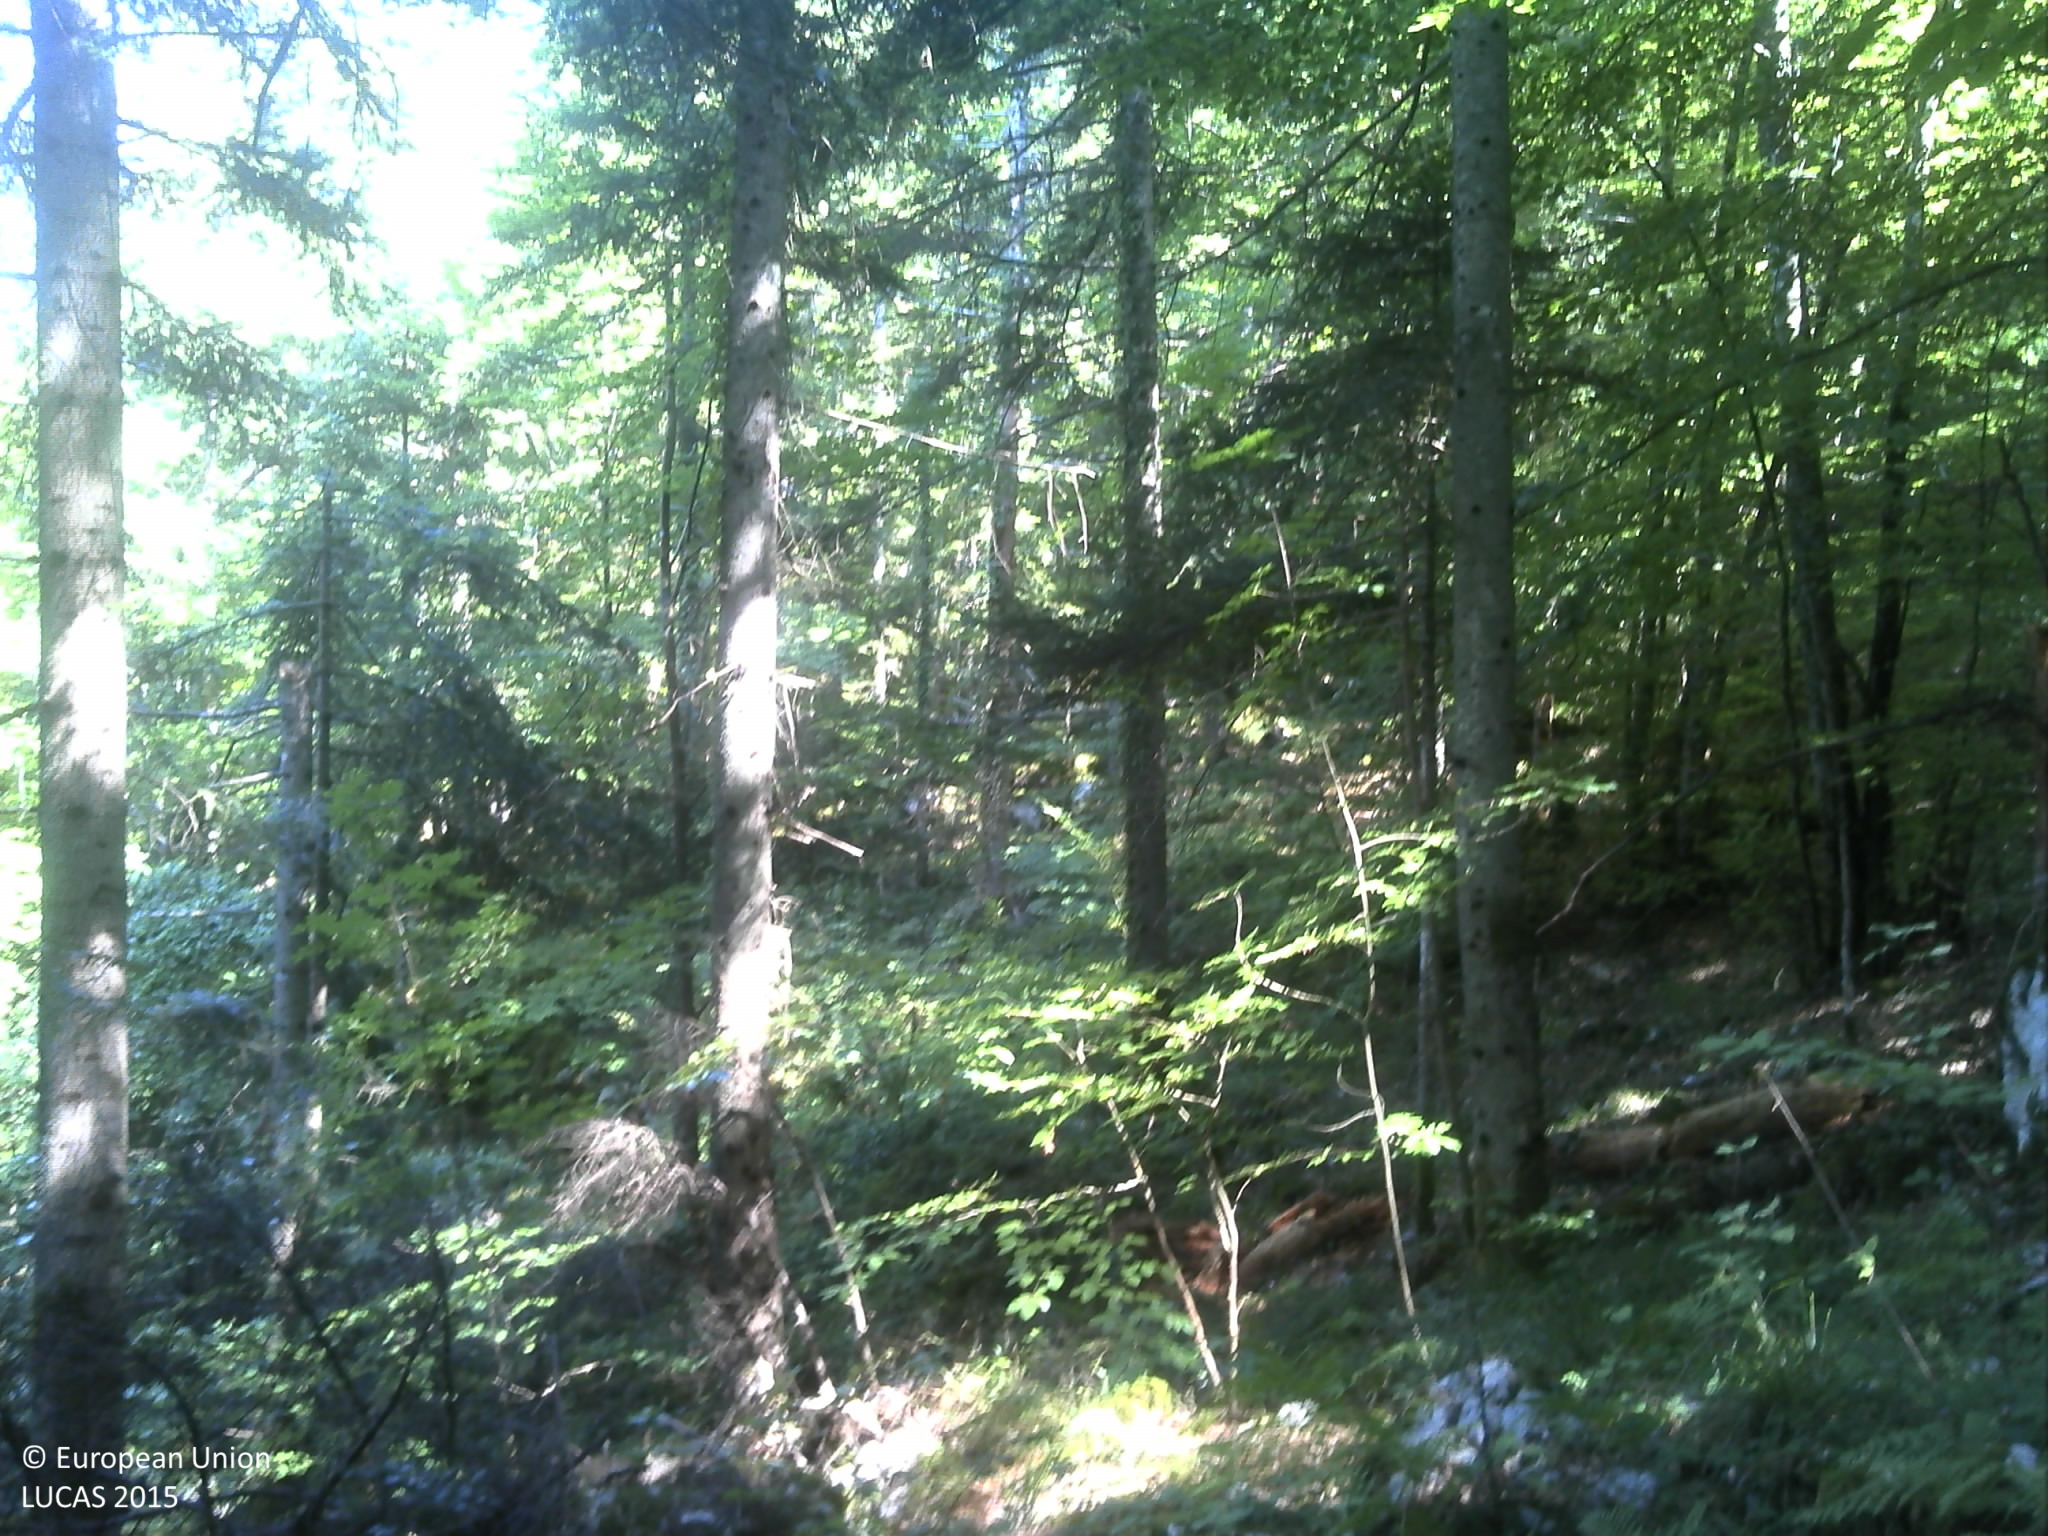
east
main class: Woodland
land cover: Other mixed woodland
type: beech forest
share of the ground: > 75 %
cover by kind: broadleaved forest trees 55 %, coniferous forest trees 30 %, lichens and mosses 5 %, consolidated bare surface 5 %, unconsolidated bare surface 5 %
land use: Forestry
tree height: > 5 m
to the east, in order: Other mixed woodland
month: August
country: HR
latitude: 44.7052
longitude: 15.2568
